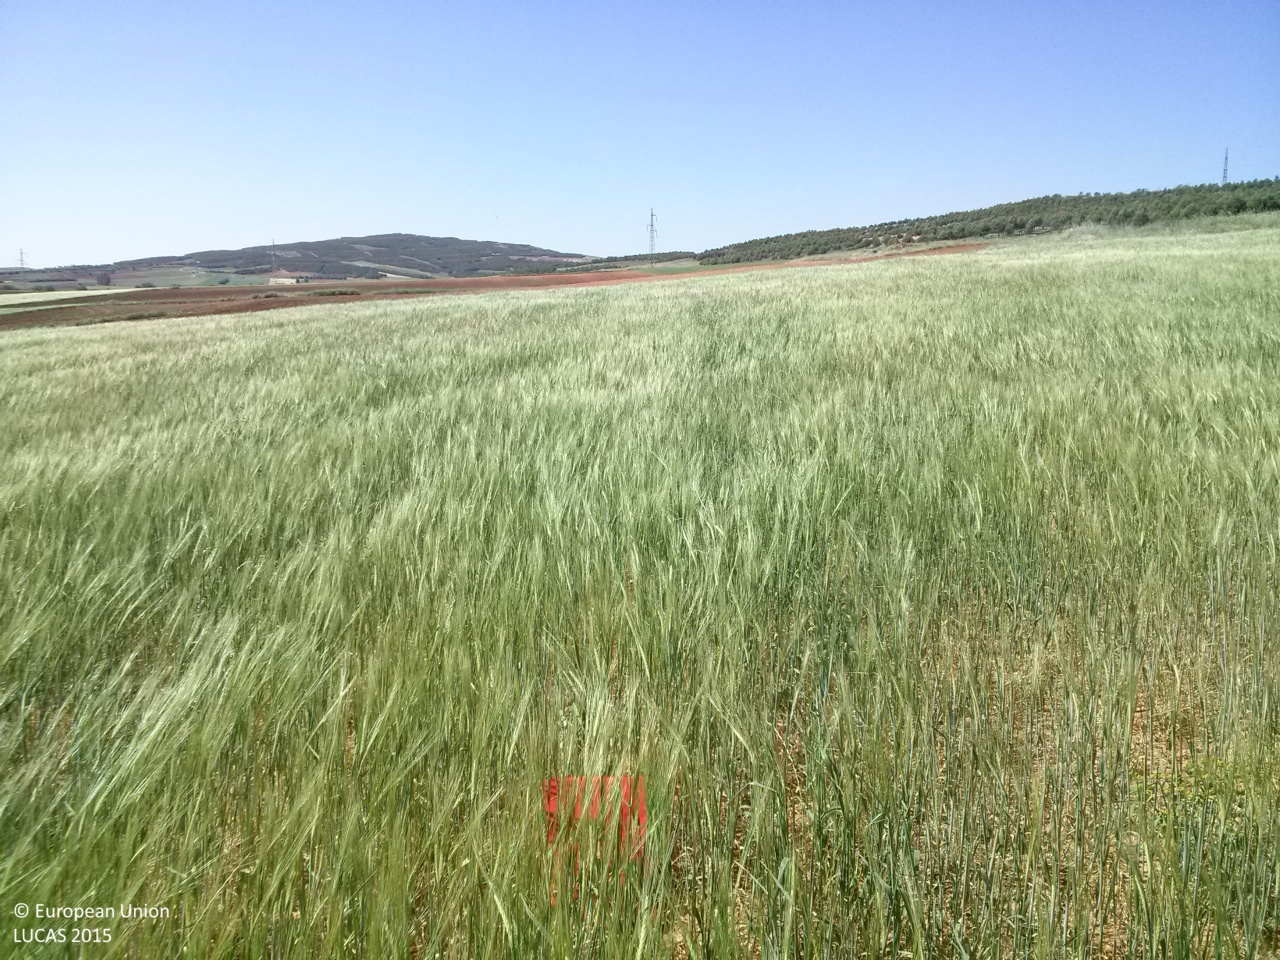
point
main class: Cropland
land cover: Barley
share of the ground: > 75 %
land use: Agriculture (excluding fallow land and kitchen gardens)
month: May
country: ES
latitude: 40.0072
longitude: -2.8257
